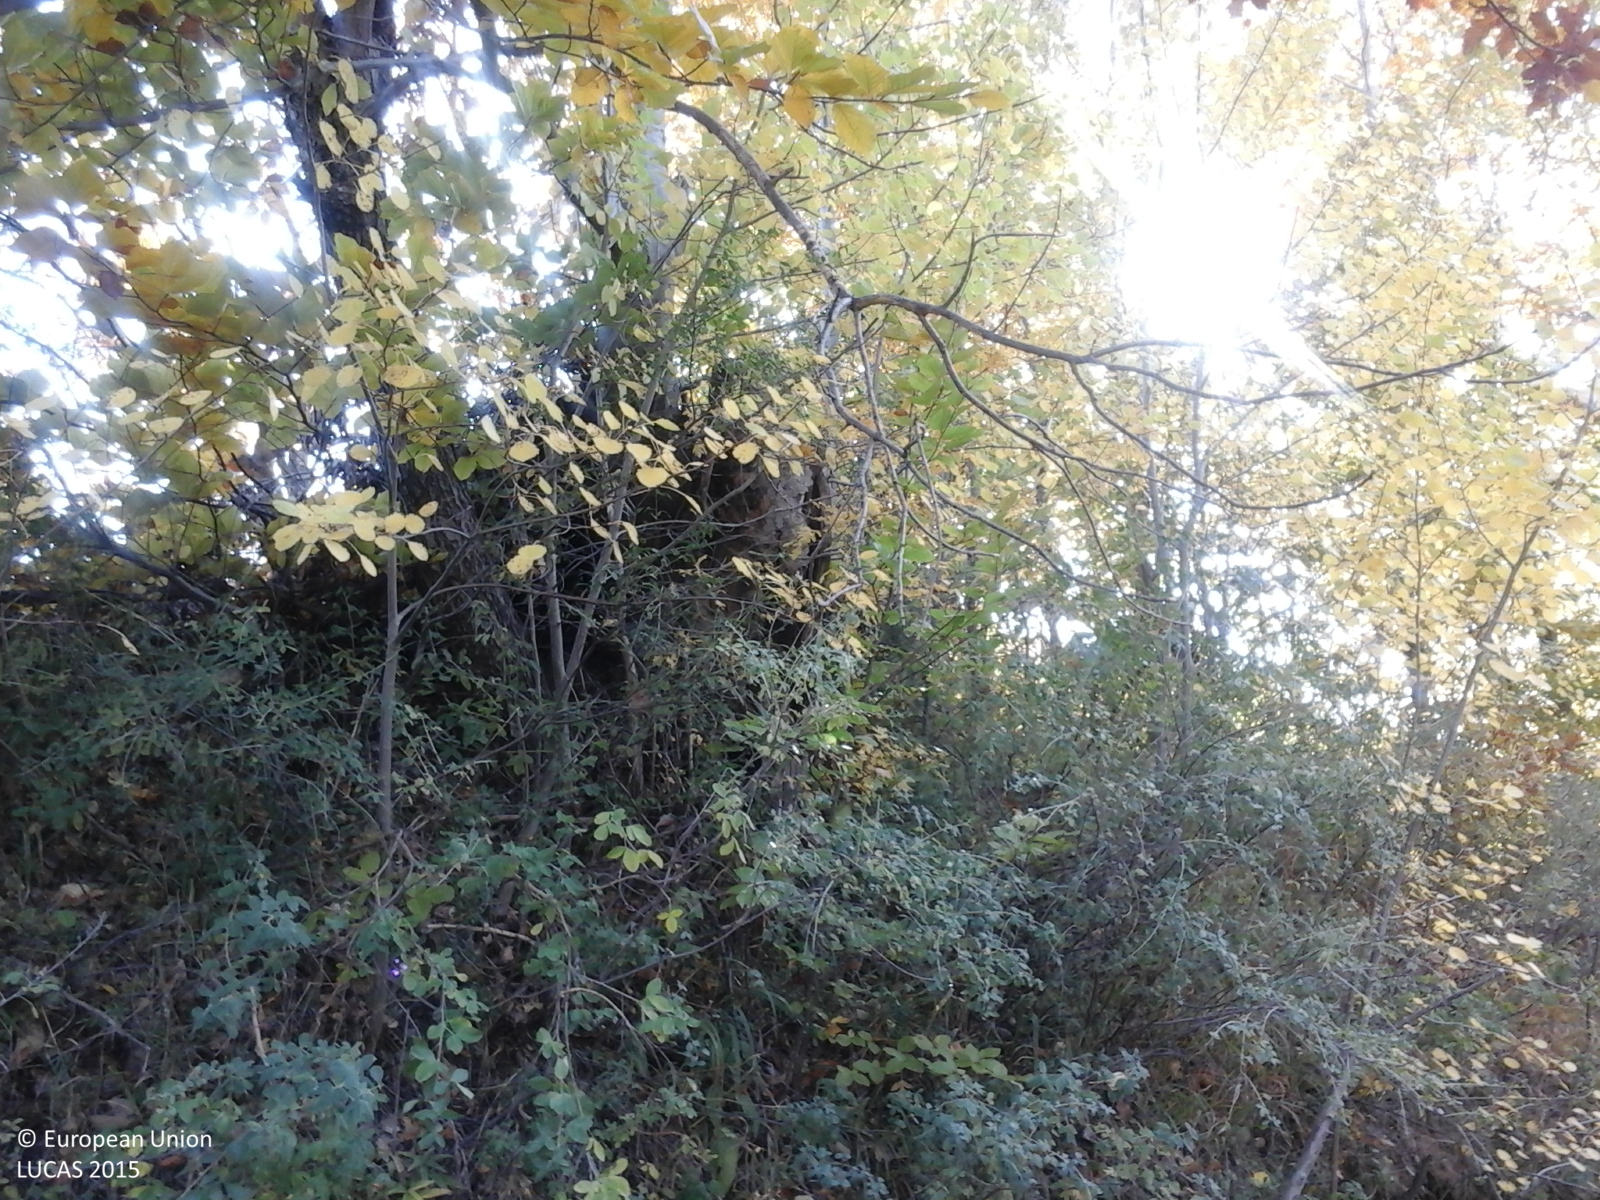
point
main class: Woodland
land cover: Broadleaved woodland
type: beech forest
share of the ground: > 75 %
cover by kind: broadleaved forest trees 100 %
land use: Forestry
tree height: > 5 m
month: October
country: RO
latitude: 45.6058
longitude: 26.8687
